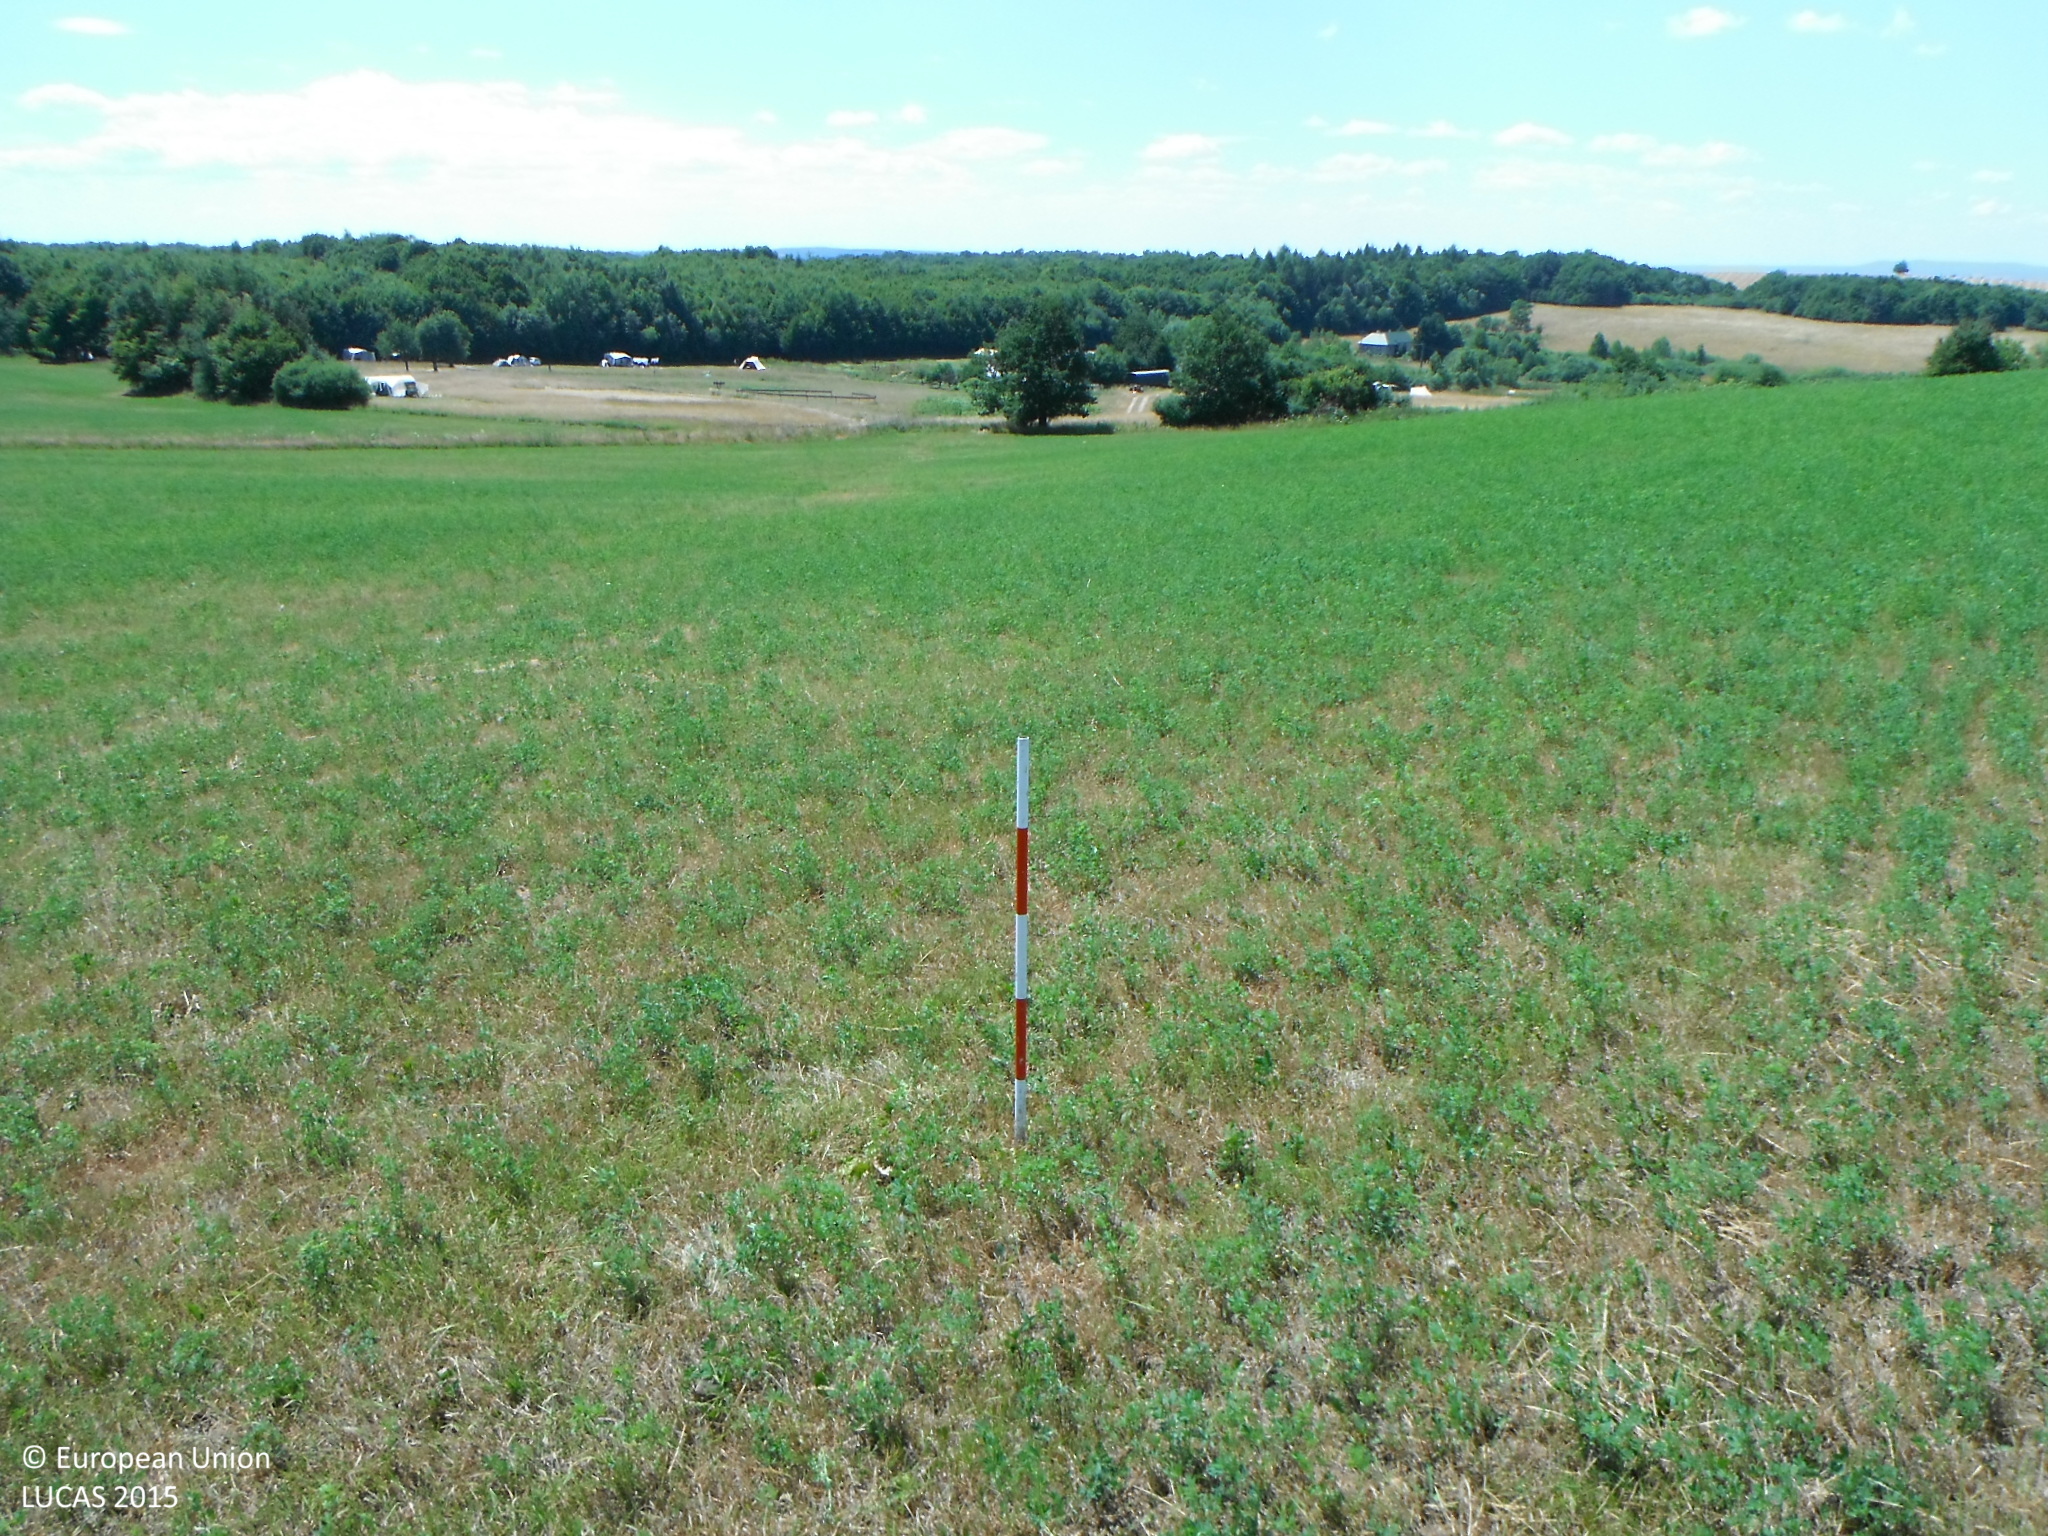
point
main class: Cropland
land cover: Other leguminous and mixtures for fodder
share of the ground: > 75 %
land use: Agriculture (excluding fallow land and kitchen gardens)
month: July
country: SK
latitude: 48.2529
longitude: 19.2207
